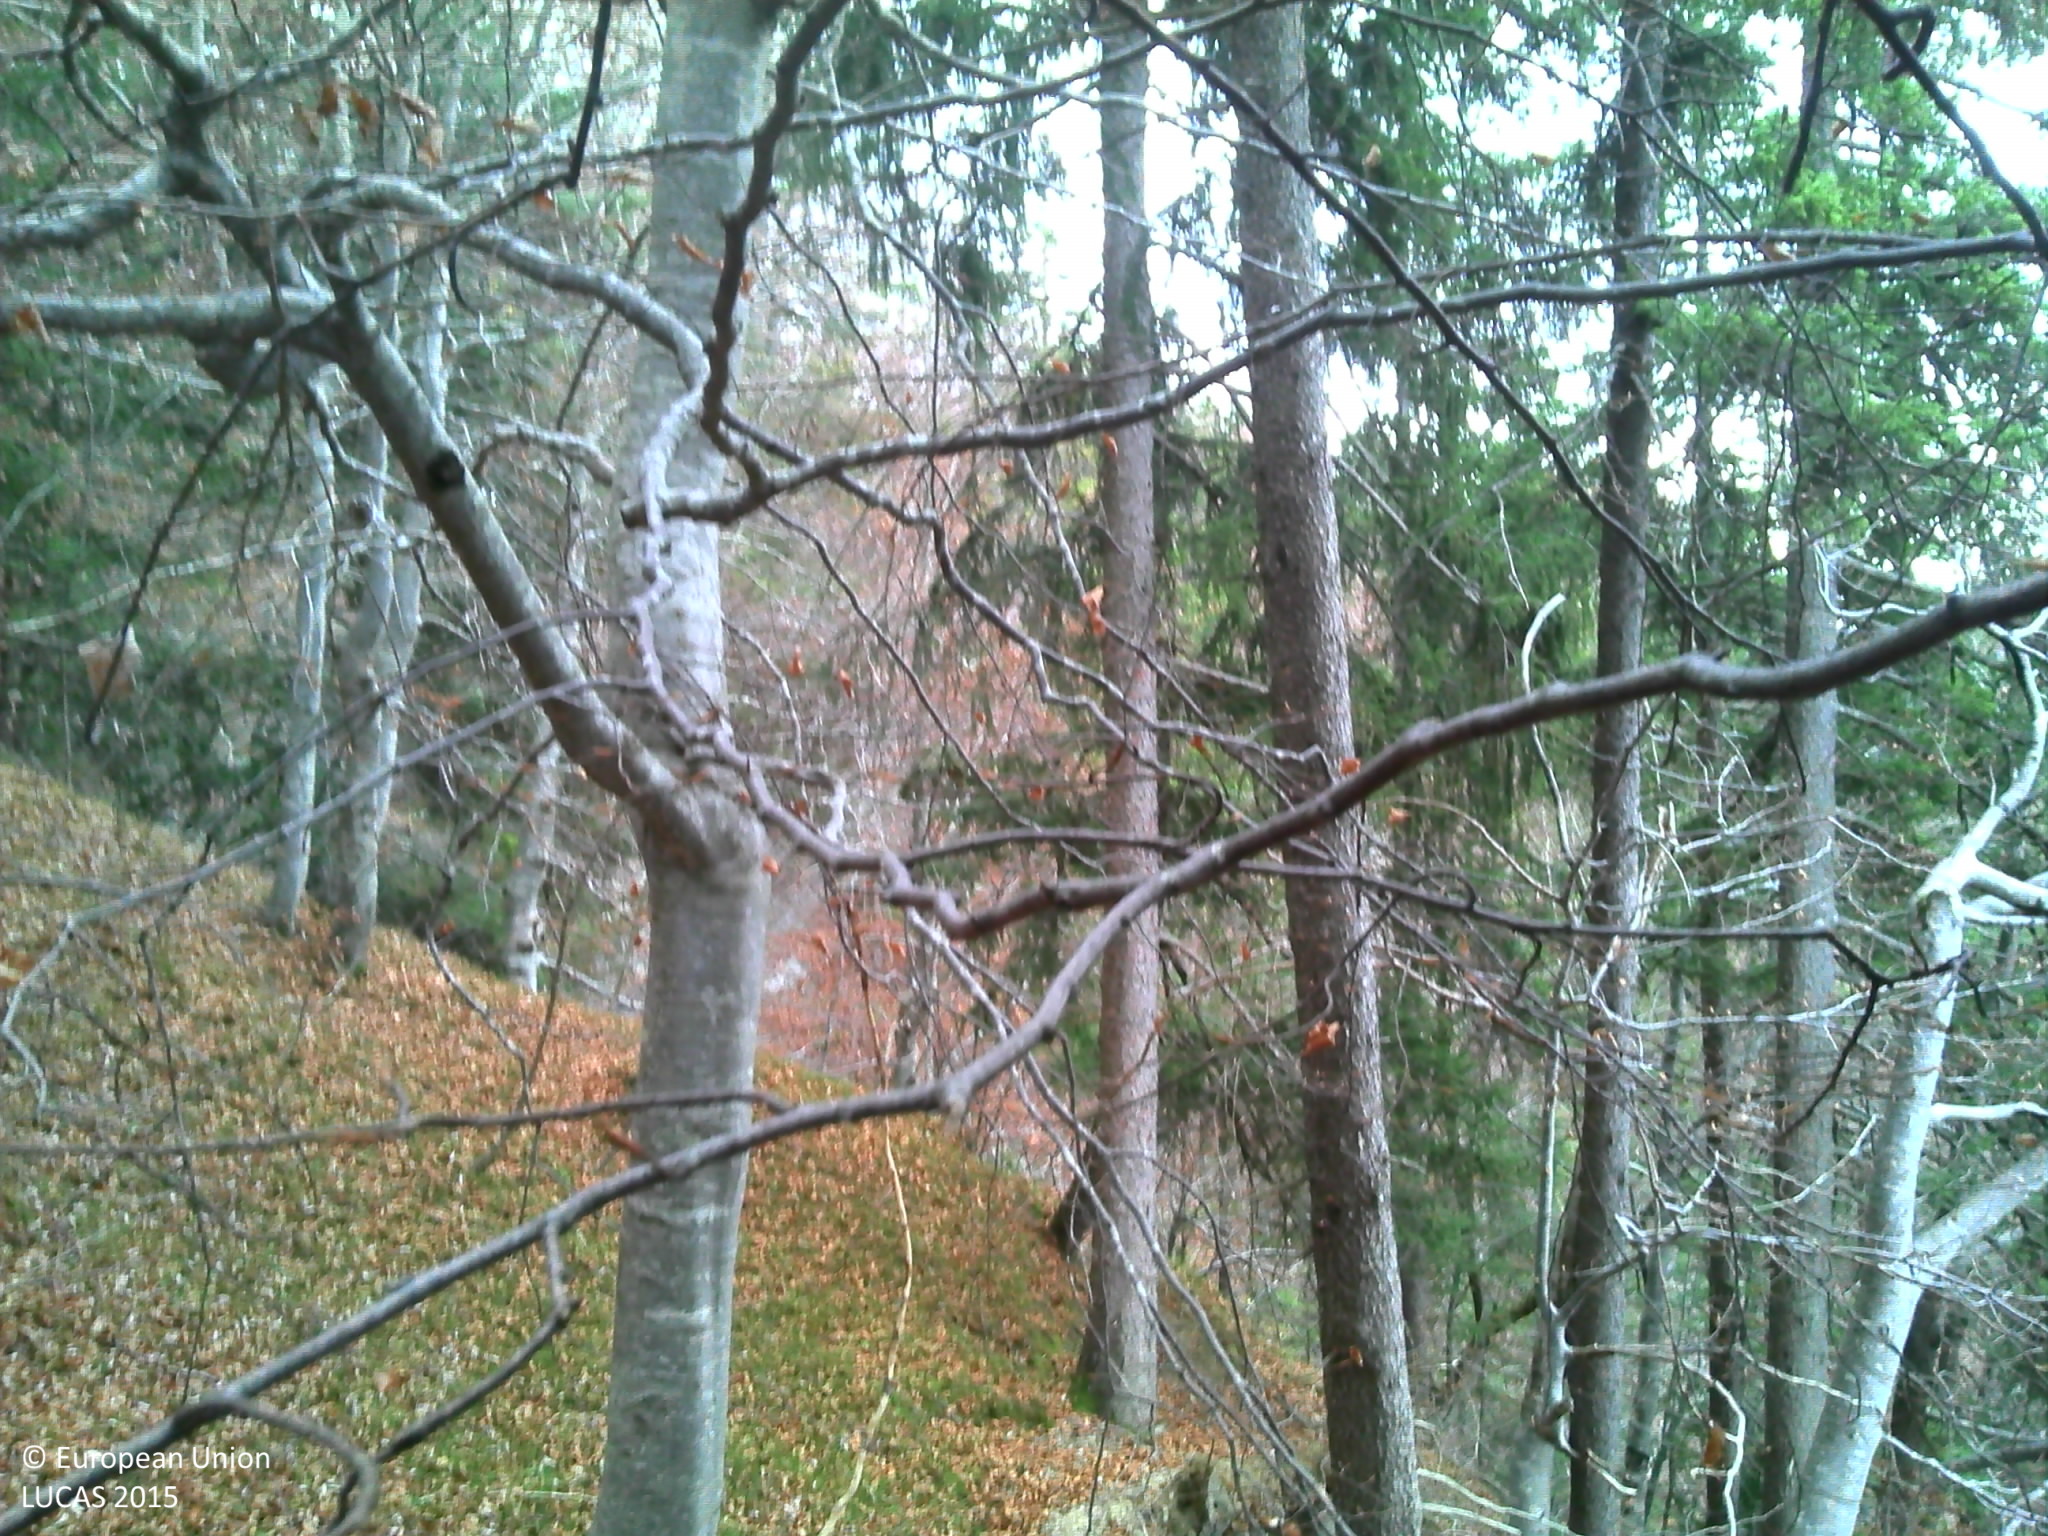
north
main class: Woodland
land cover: Spruce dominated mixed woodland
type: mountainous beech forest
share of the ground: > 75 %
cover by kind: coniferous forest trees 50 %, broadleaved forest trees 30 %, herbaceous plants 10 %, consolidated bare surface 10 %
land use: Forestry
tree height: > 5 m
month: November
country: FR
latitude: 45.8068
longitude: 6.4912
